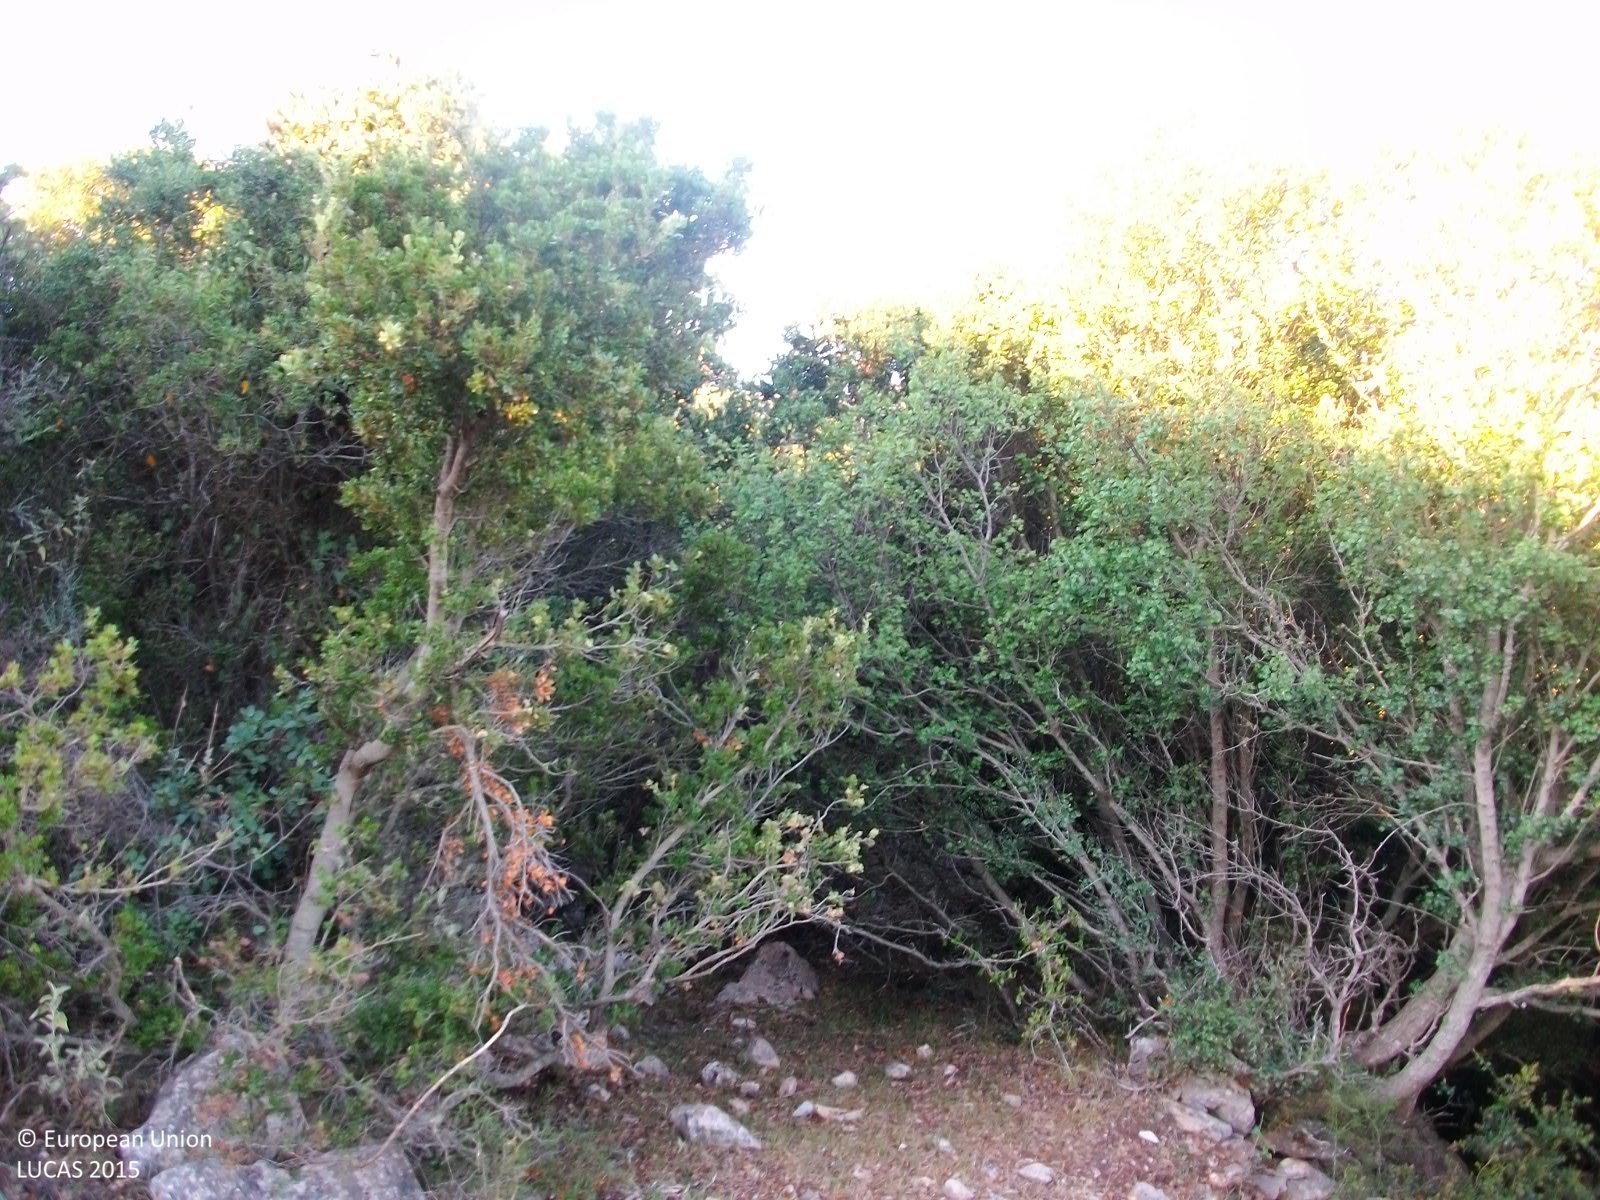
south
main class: Woodland
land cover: Broadleaved woodland
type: broadleaved evergreen forest
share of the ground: > 75 %
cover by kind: broadleaved forest trees 100 %
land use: Semi-natural and natural areas not in use
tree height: > 5 m
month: July
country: GR
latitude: 36.9469
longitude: 21.8652
